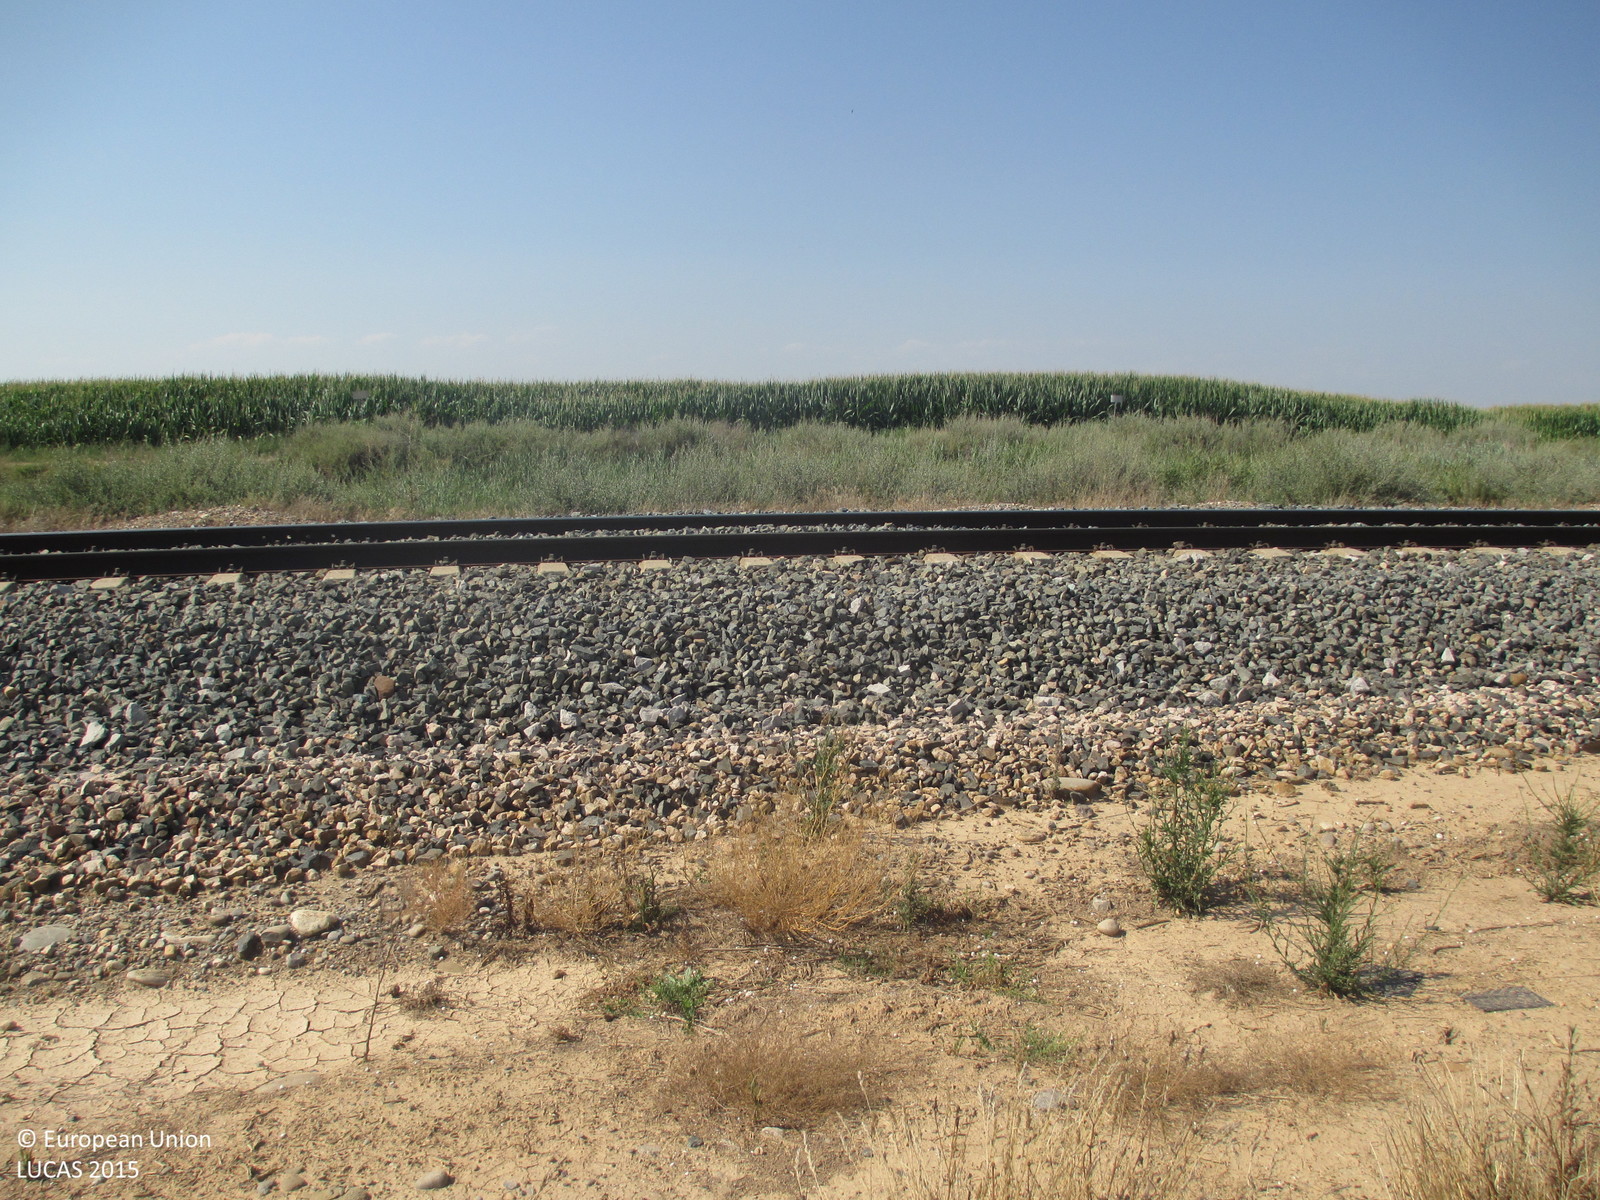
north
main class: Grassland
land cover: Spontaneously vegetated surfaces
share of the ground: 10 - 25 %
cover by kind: unconsolidated bare surface 65 %, herbaceous plants 15 %
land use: Railway transport
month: July
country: ES
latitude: 41.8962
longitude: 0.1112
